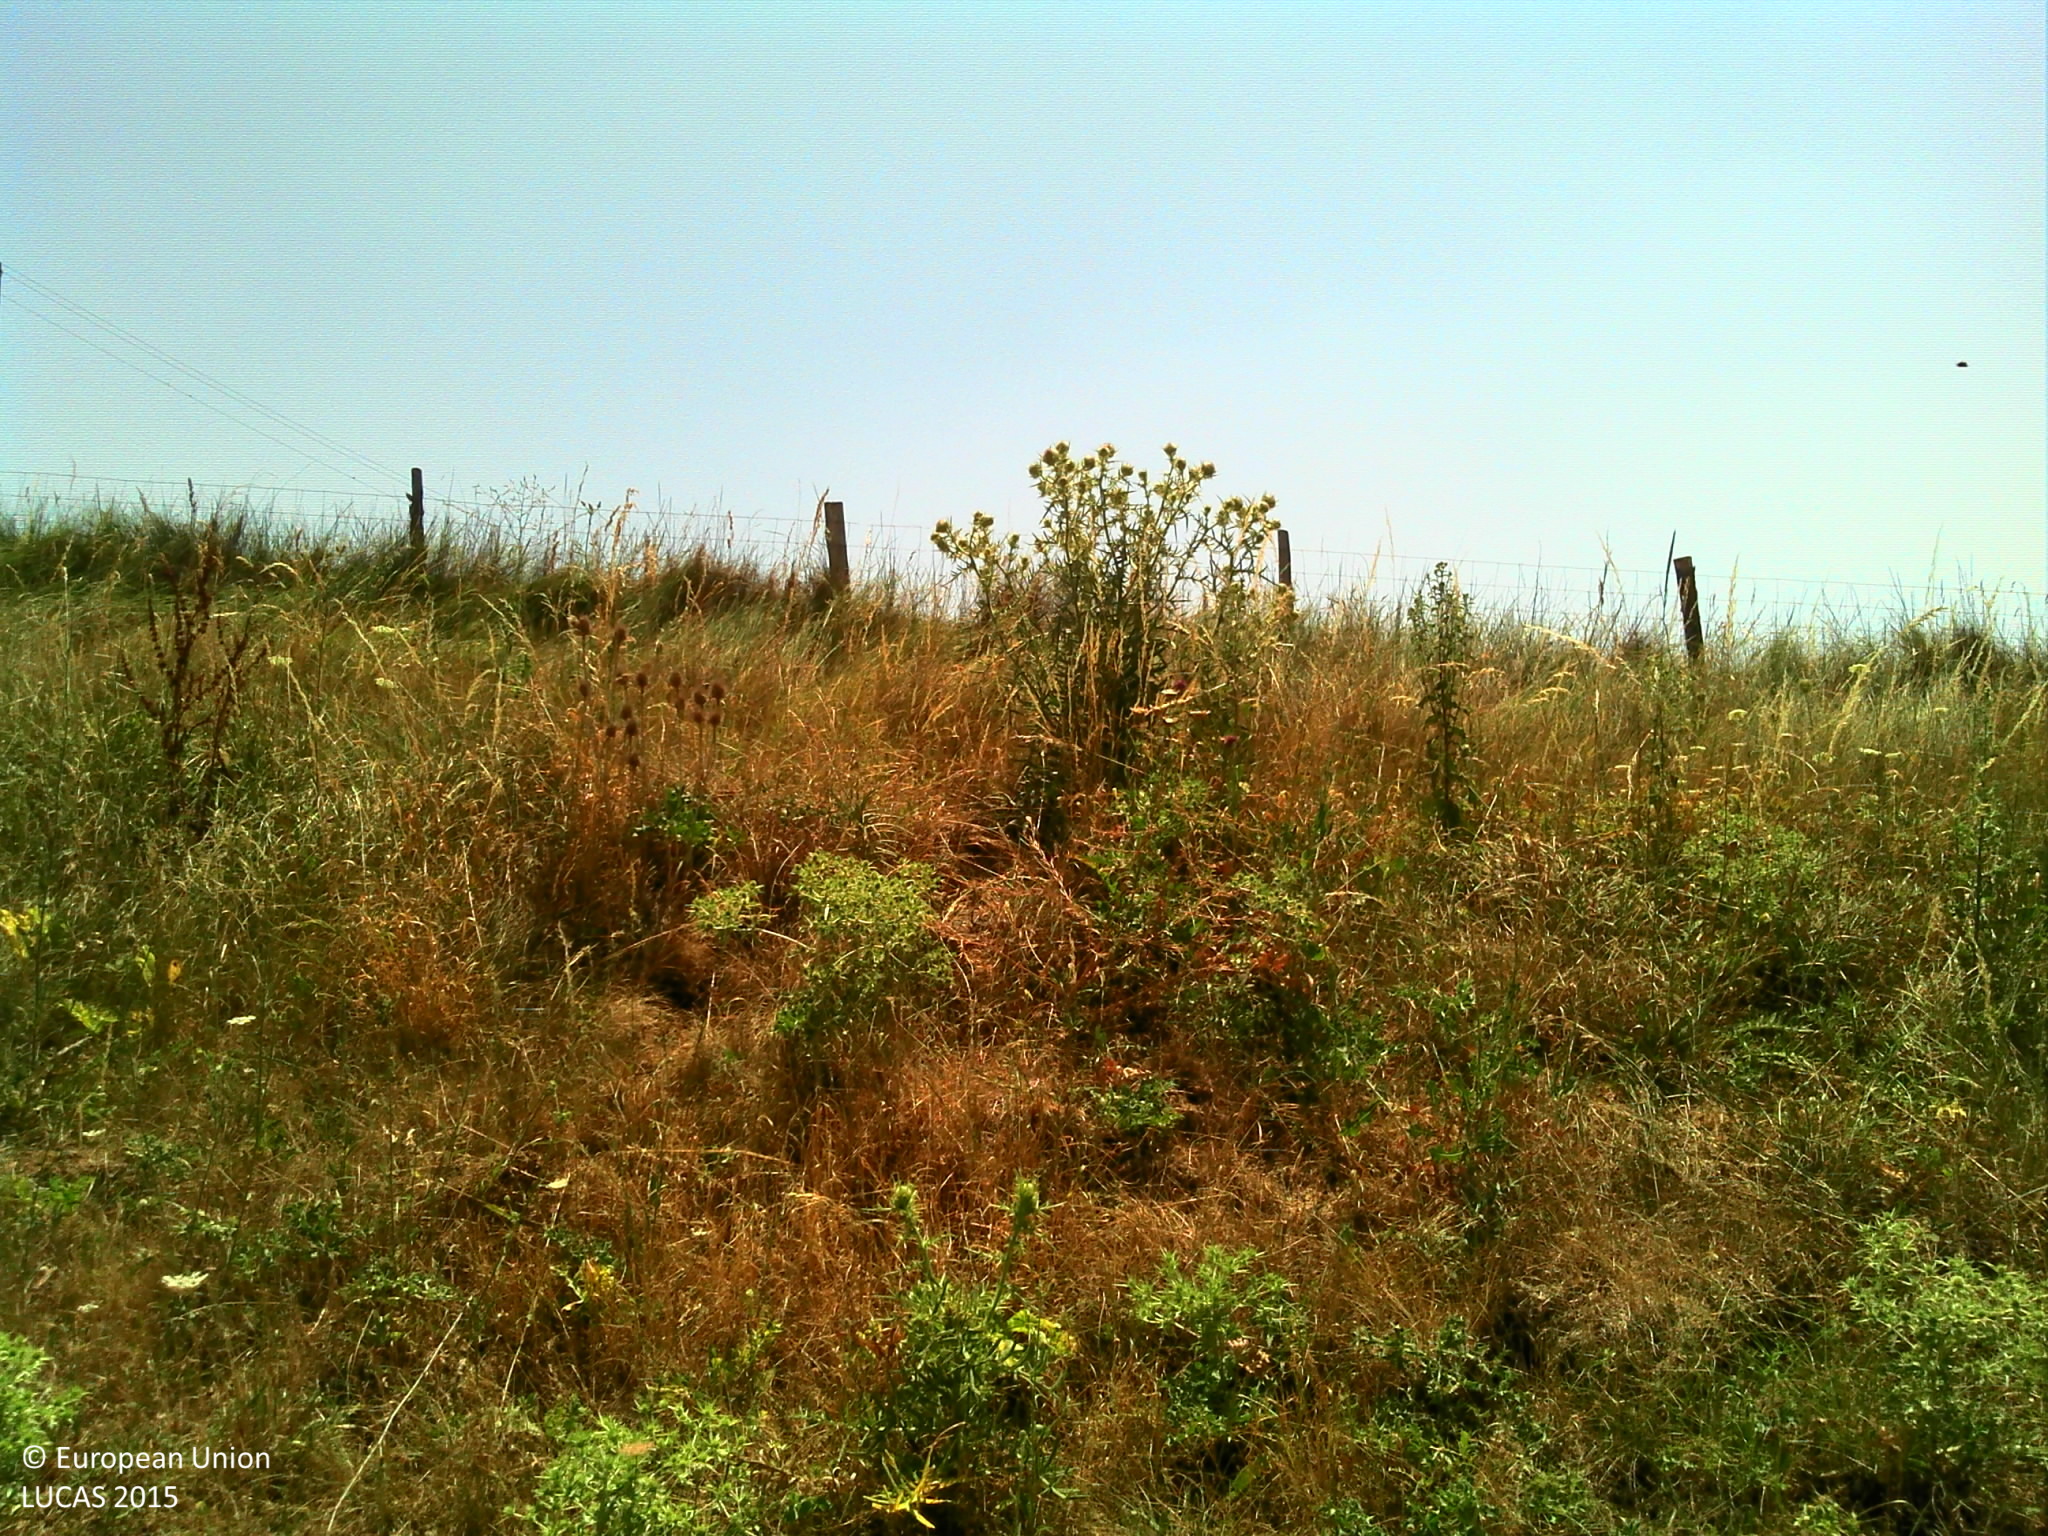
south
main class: Grassland
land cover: Grassland without tree/shrub cover
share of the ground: > 75 %
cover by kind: herbaceous plants 100 %
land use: Agriculture (excluding fallow land and kitchen gardens)
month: July
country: FR
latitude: 44.1743
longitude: 3.0889
